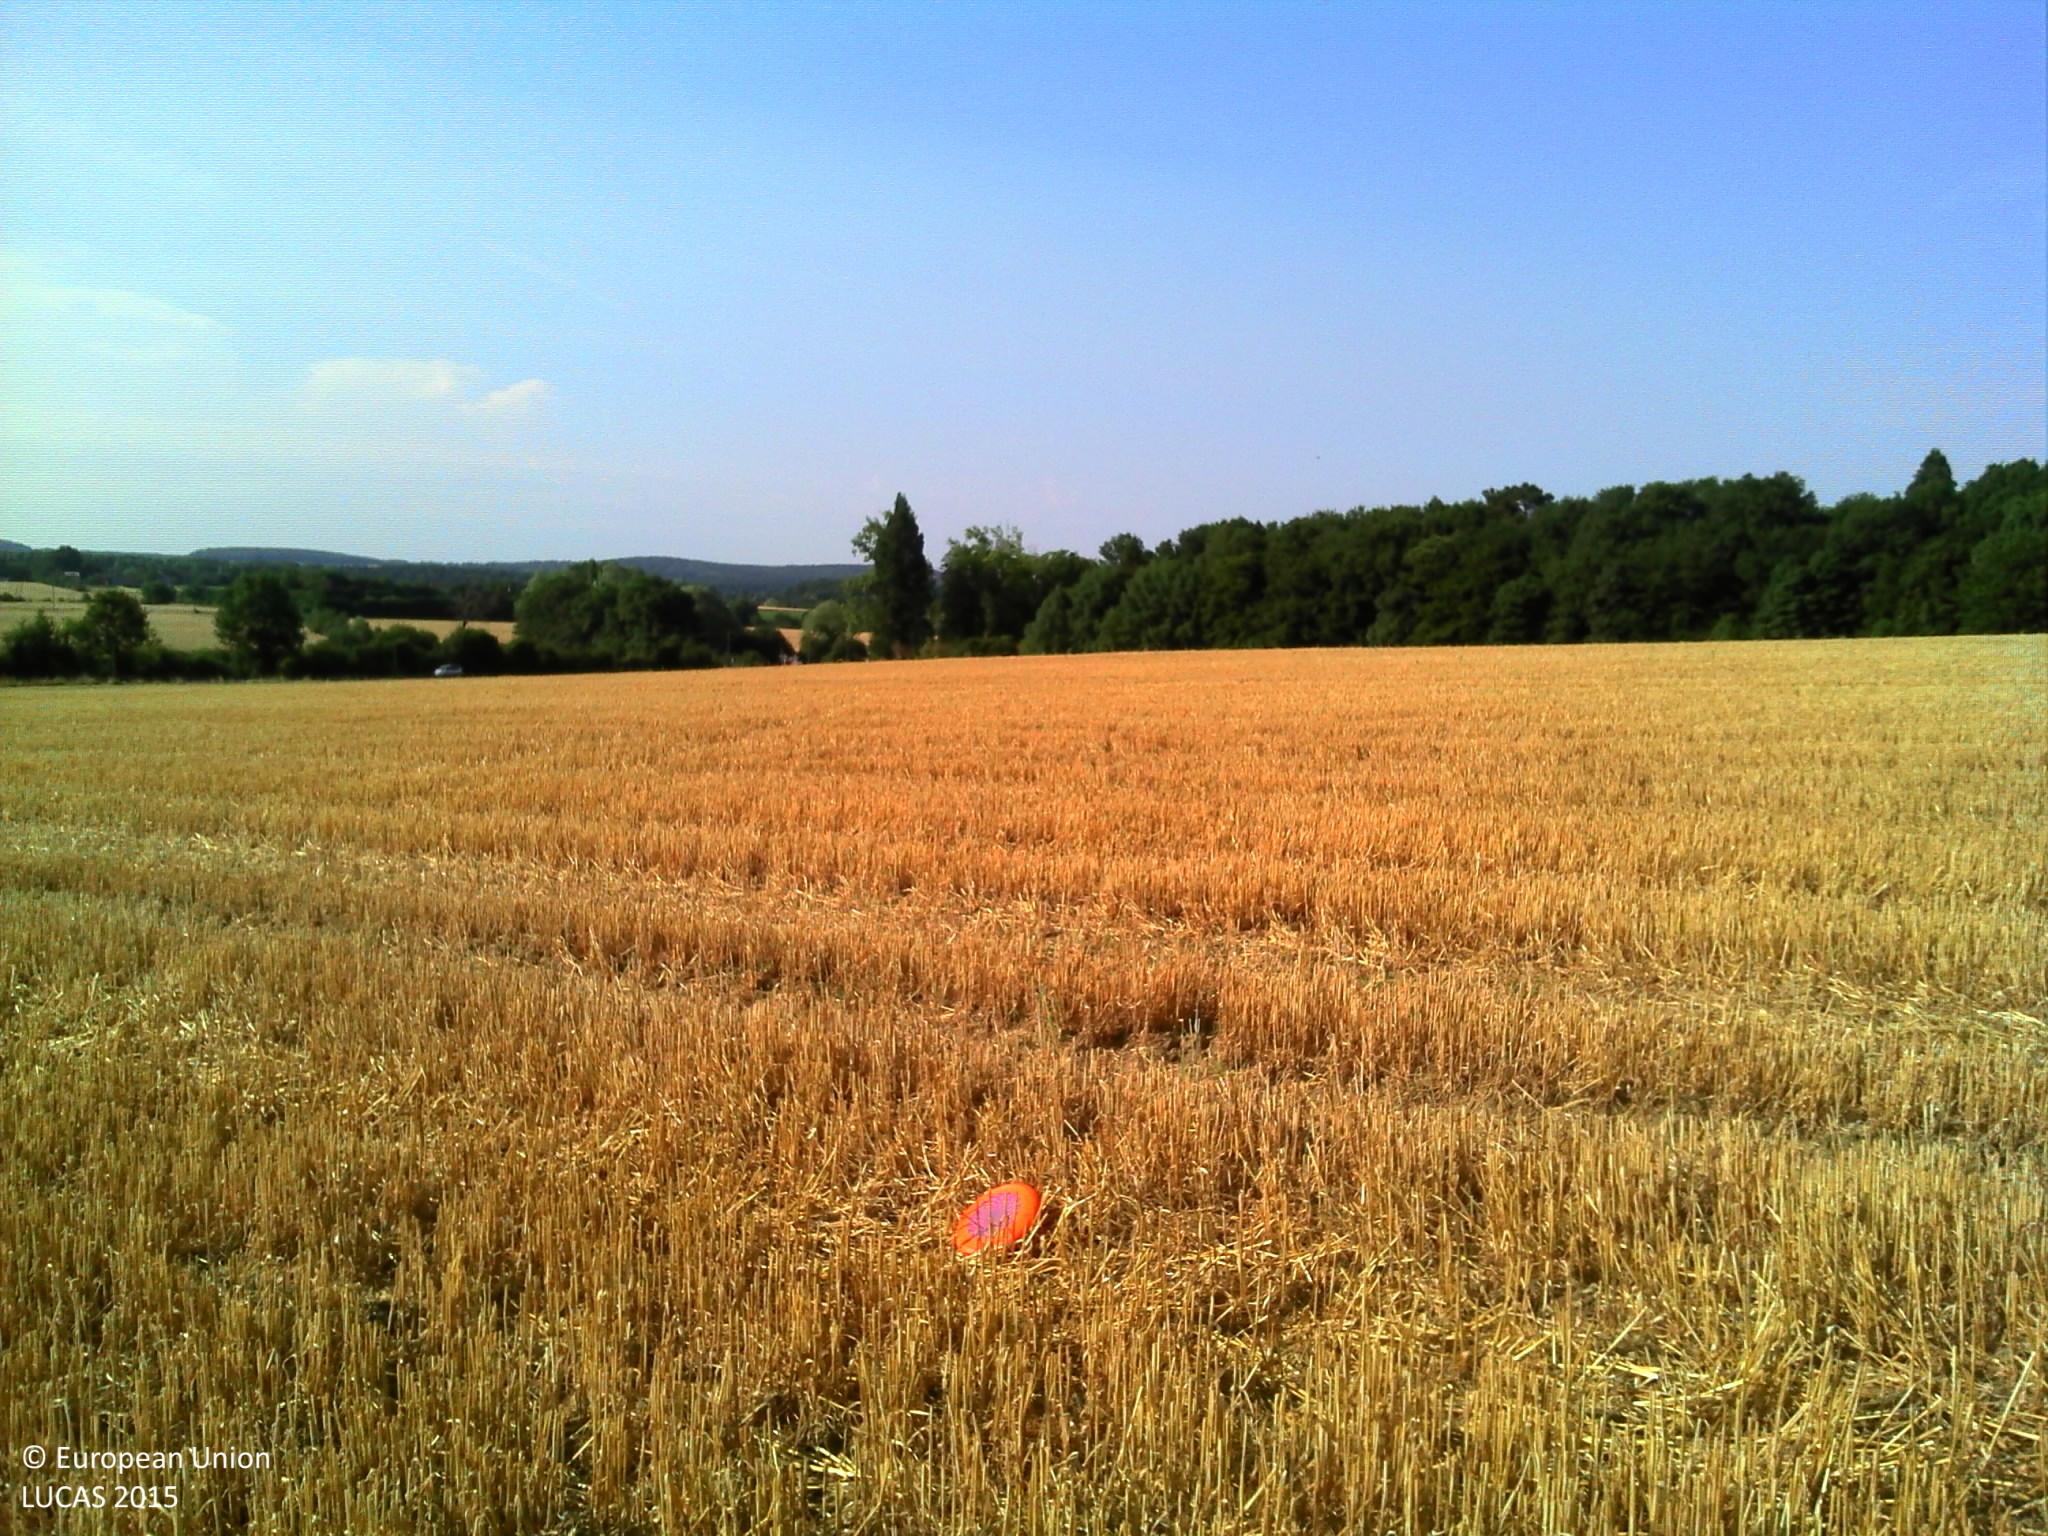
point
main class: Cropland
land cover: Barley
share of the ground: > 75 %
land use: Agriculture (excluding fallow land and kitchen gardens)
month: July
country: FR
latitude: 48.1301
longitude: 0.6121
